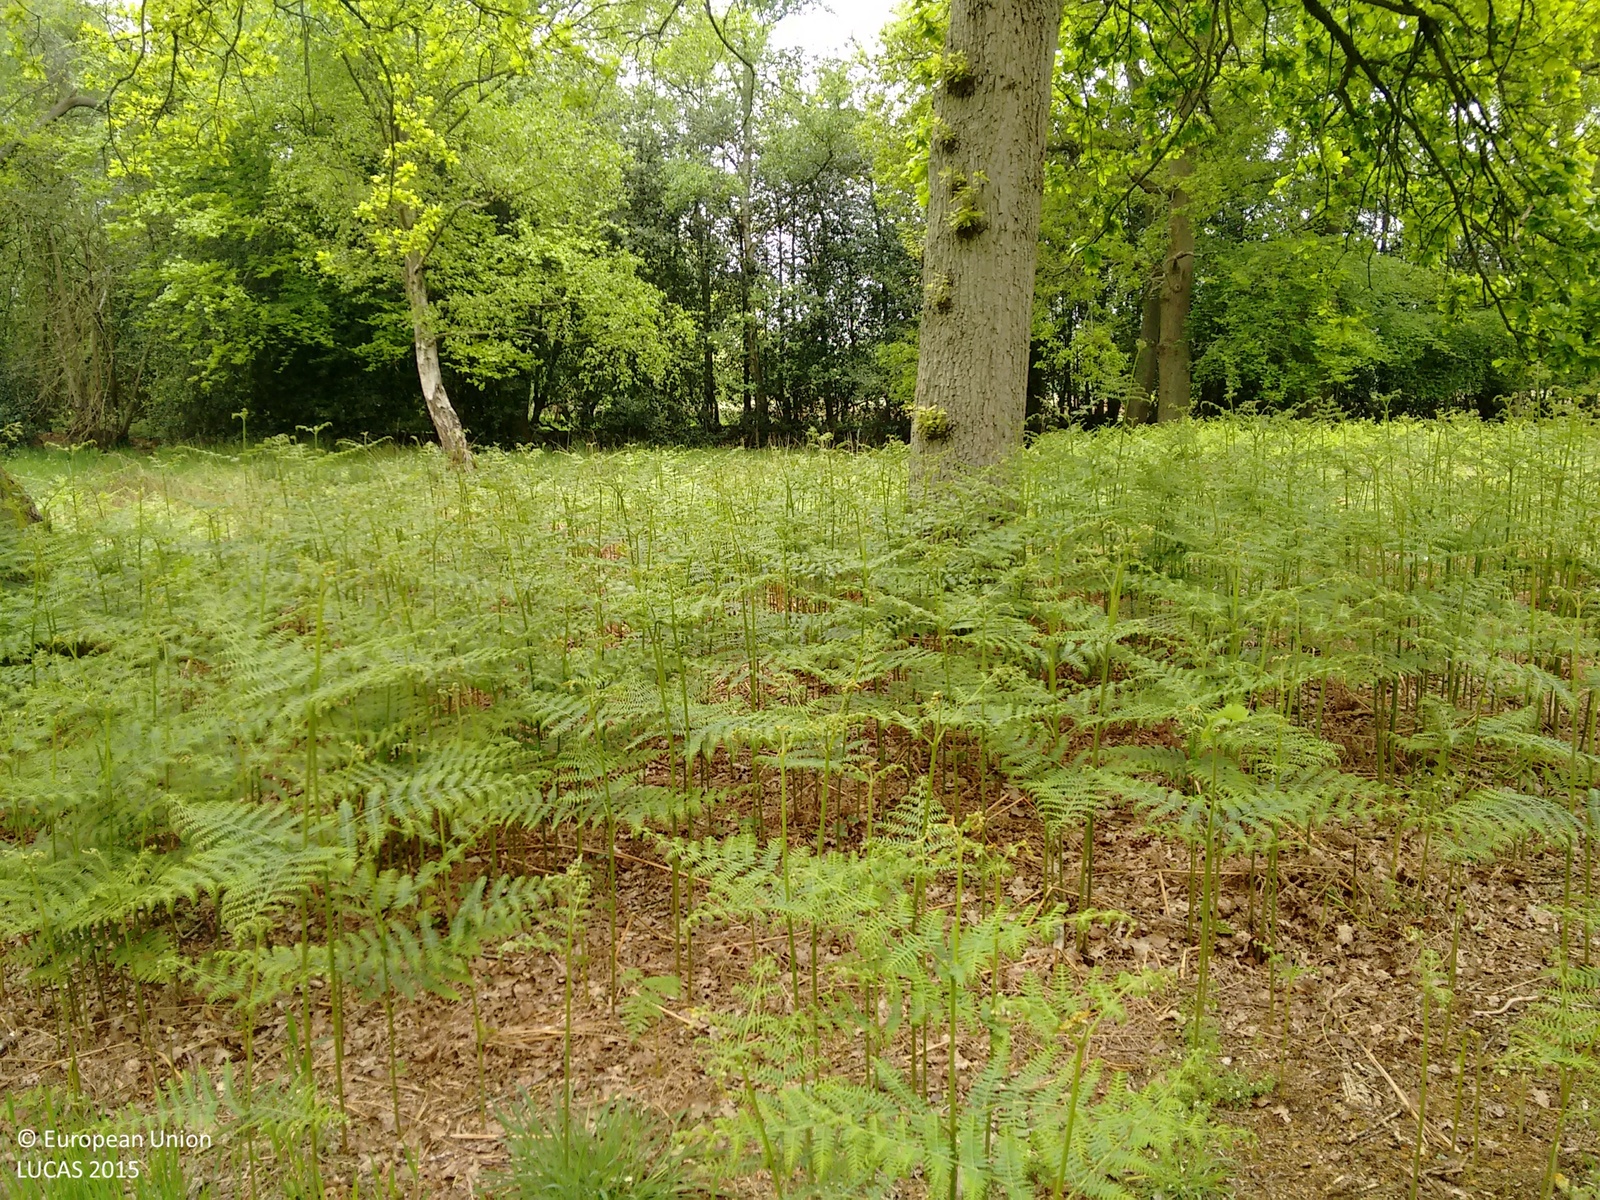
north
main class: Grassland
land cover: Spontaneously vegetated surfaces
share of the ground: 25 - 50 %
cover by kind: herbaceous plants 50 %, unconsolidated bare surface 50 %
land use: Semi-natural and natural areas not in use
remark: Clear cut
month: May
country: GB
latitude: 51.3492
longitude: -0.8833
